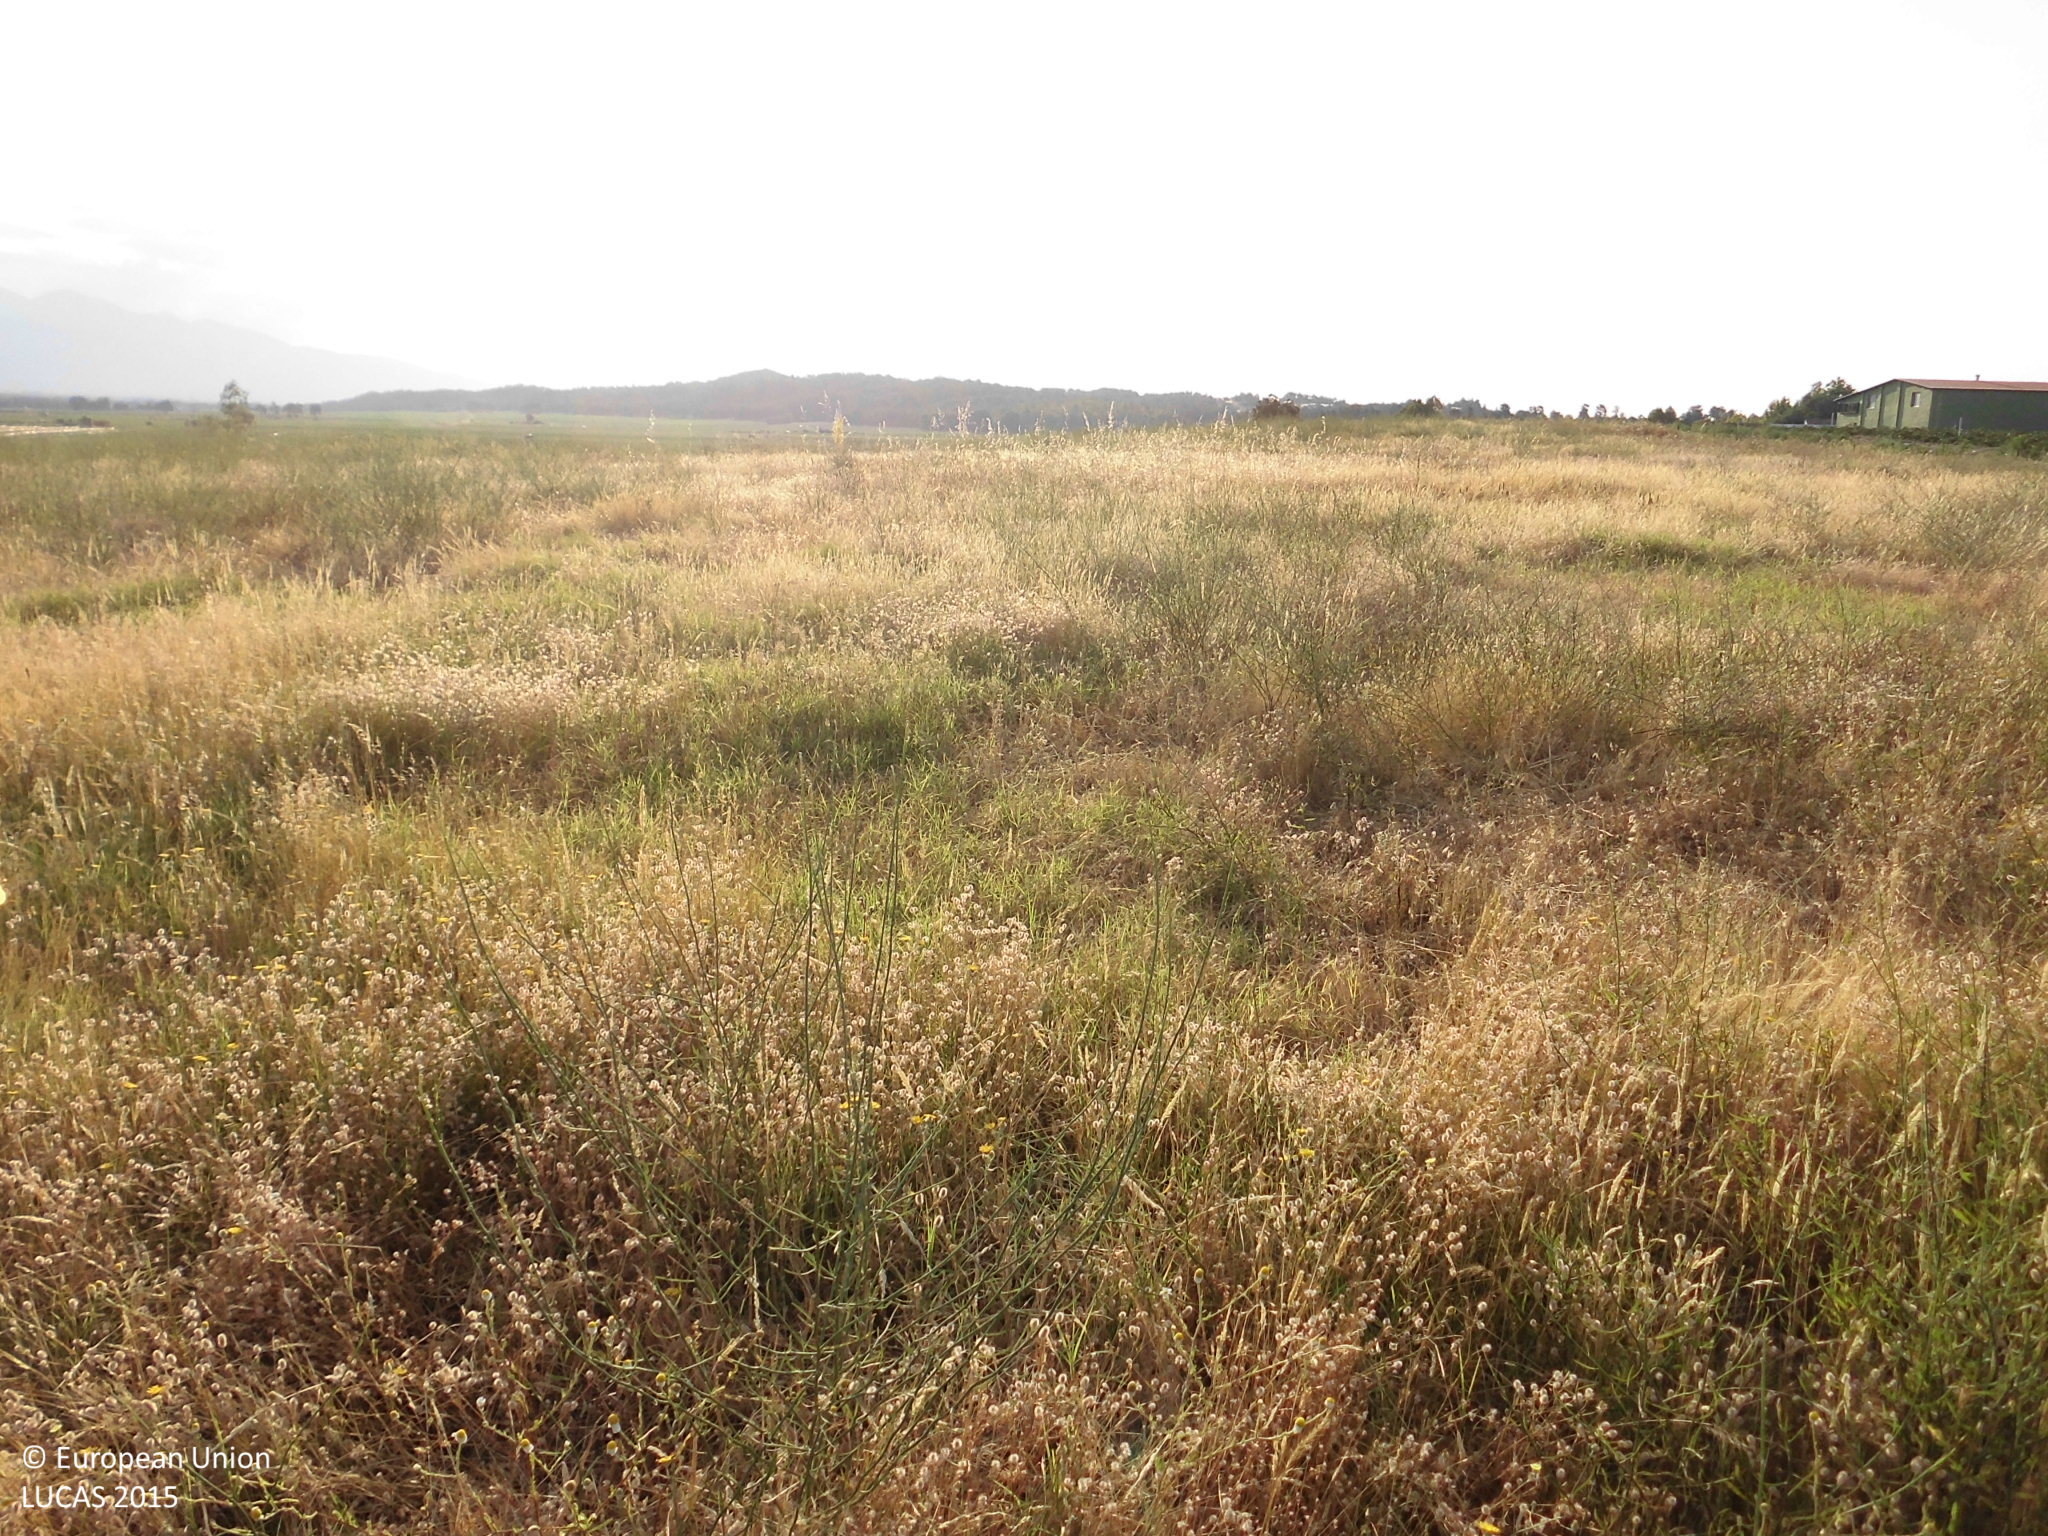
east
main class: Grassland
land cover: Spontaneously vegetated surfaces
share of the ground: > 75 %
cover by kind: herbaceous plants 100 %
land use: Fallow land
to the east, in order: Spontaneously vegetated surfaces; Tracks; Grass margins; Other bare soil; Tracks; Grass margins; Other bare soil; Shrubland with sparse tree cover
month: June
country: ES
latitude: 40.0639
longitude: -5.4538
